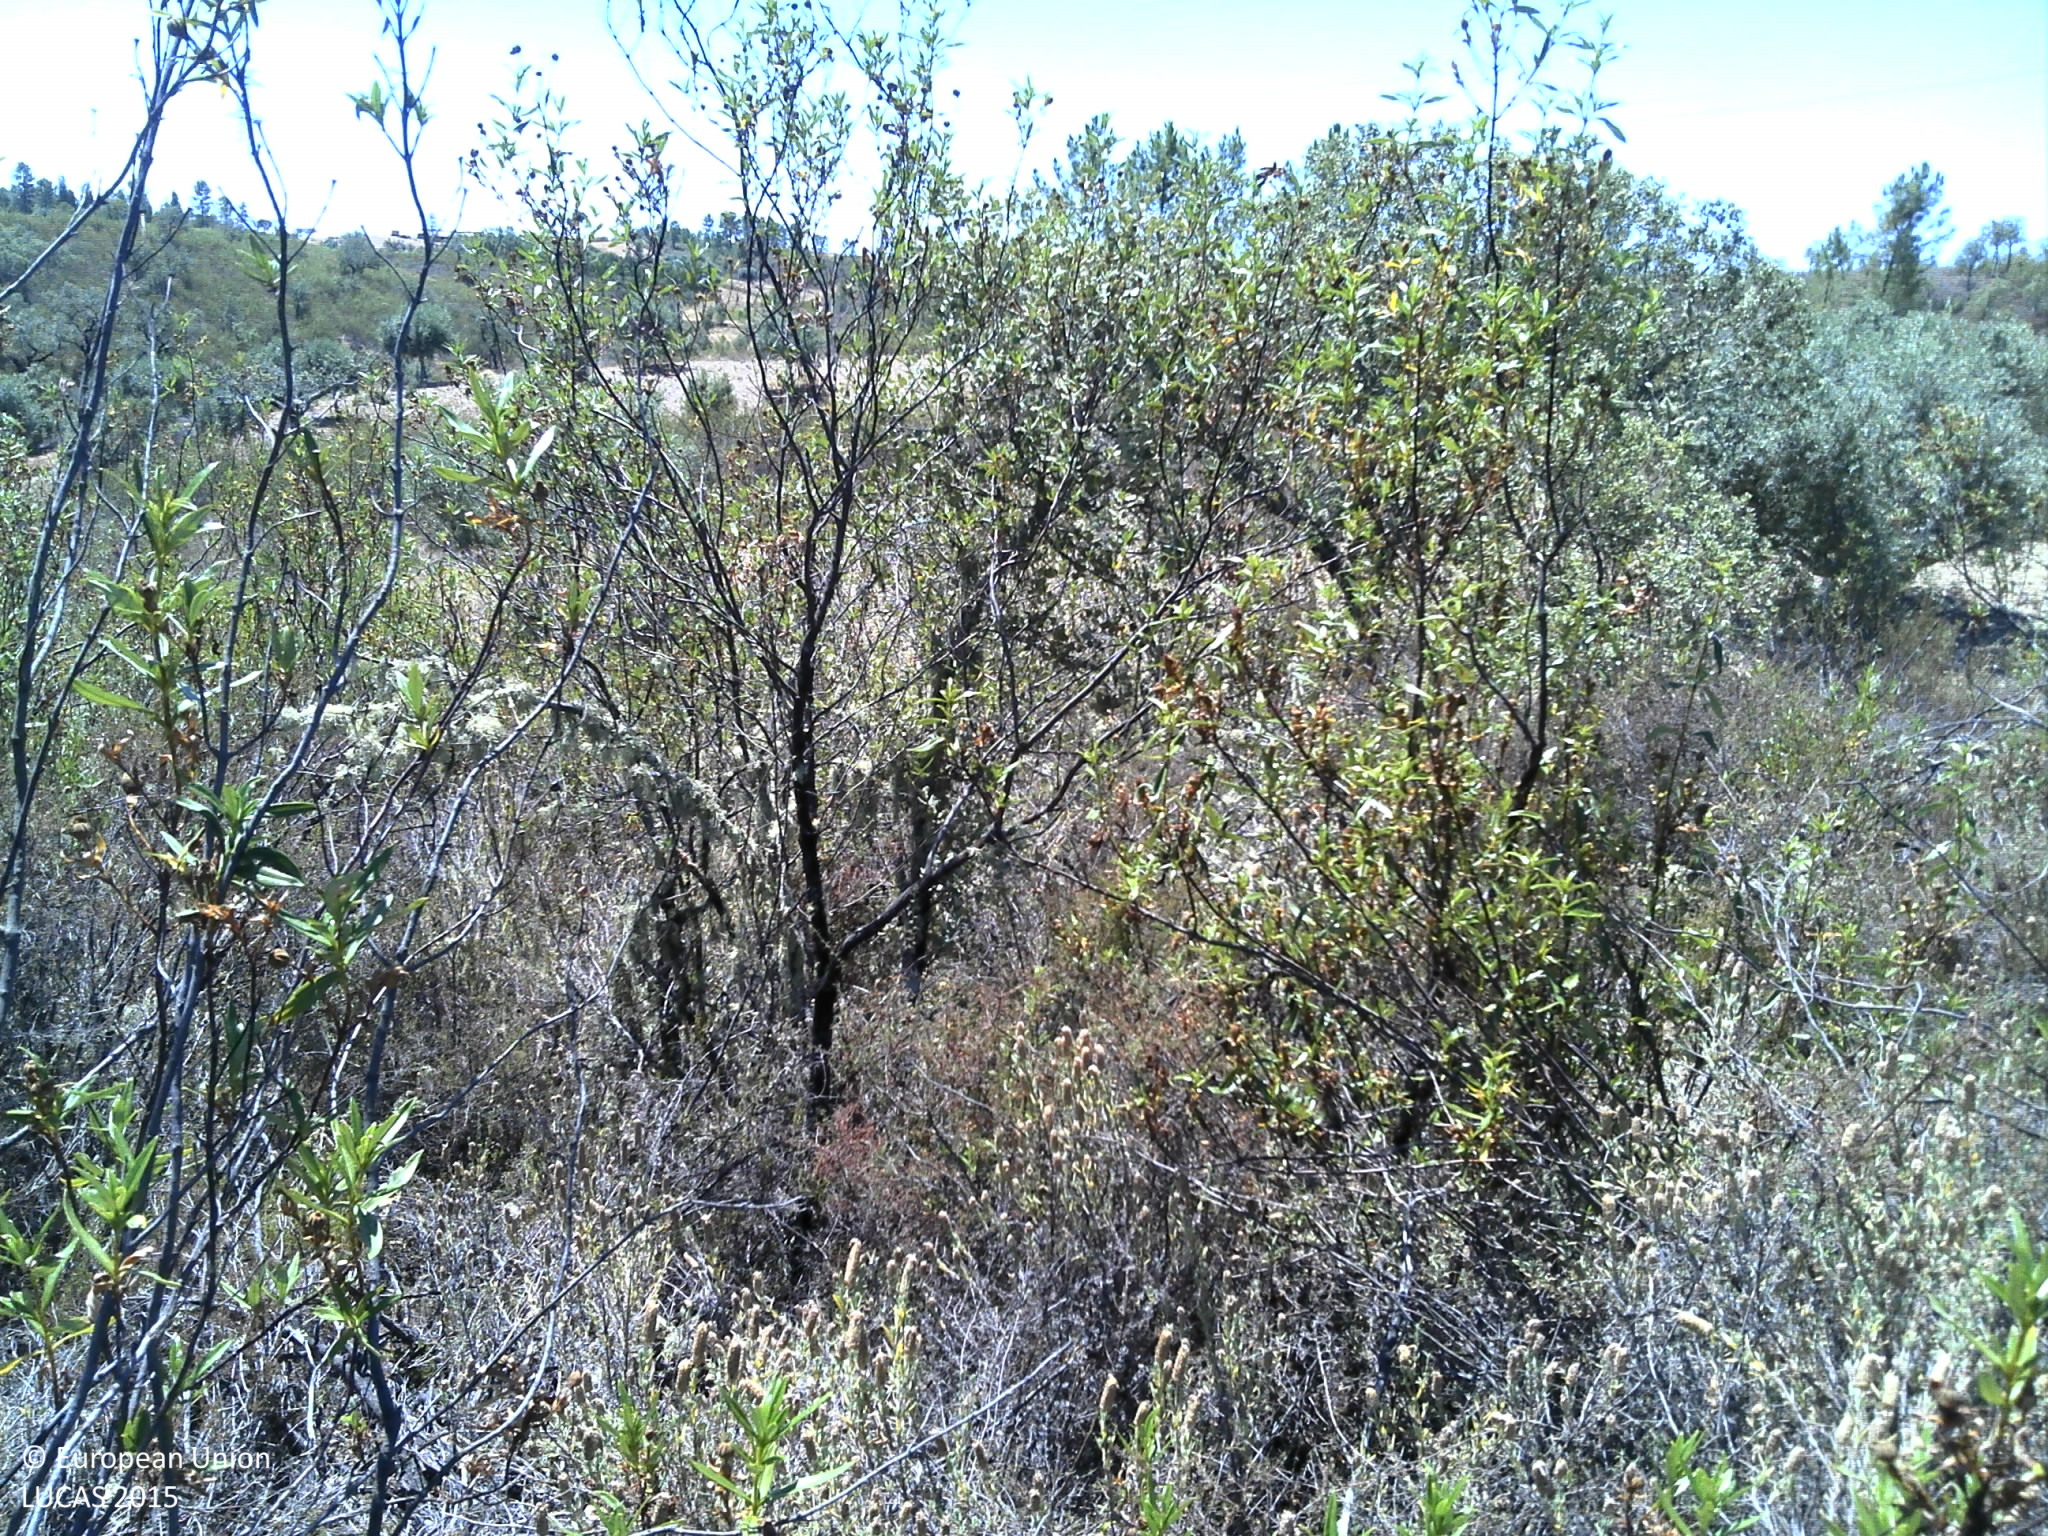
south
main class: Shrubland
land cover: Shrubland with sparse tree cover
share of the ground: > 75 %
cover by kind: shrubs 95 %, broadleaved forest trees 5 %
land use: Semi-natural and natural areas not in use
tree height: < 5 m
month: July
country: PT
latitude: 39.6753
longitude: -7.8132
